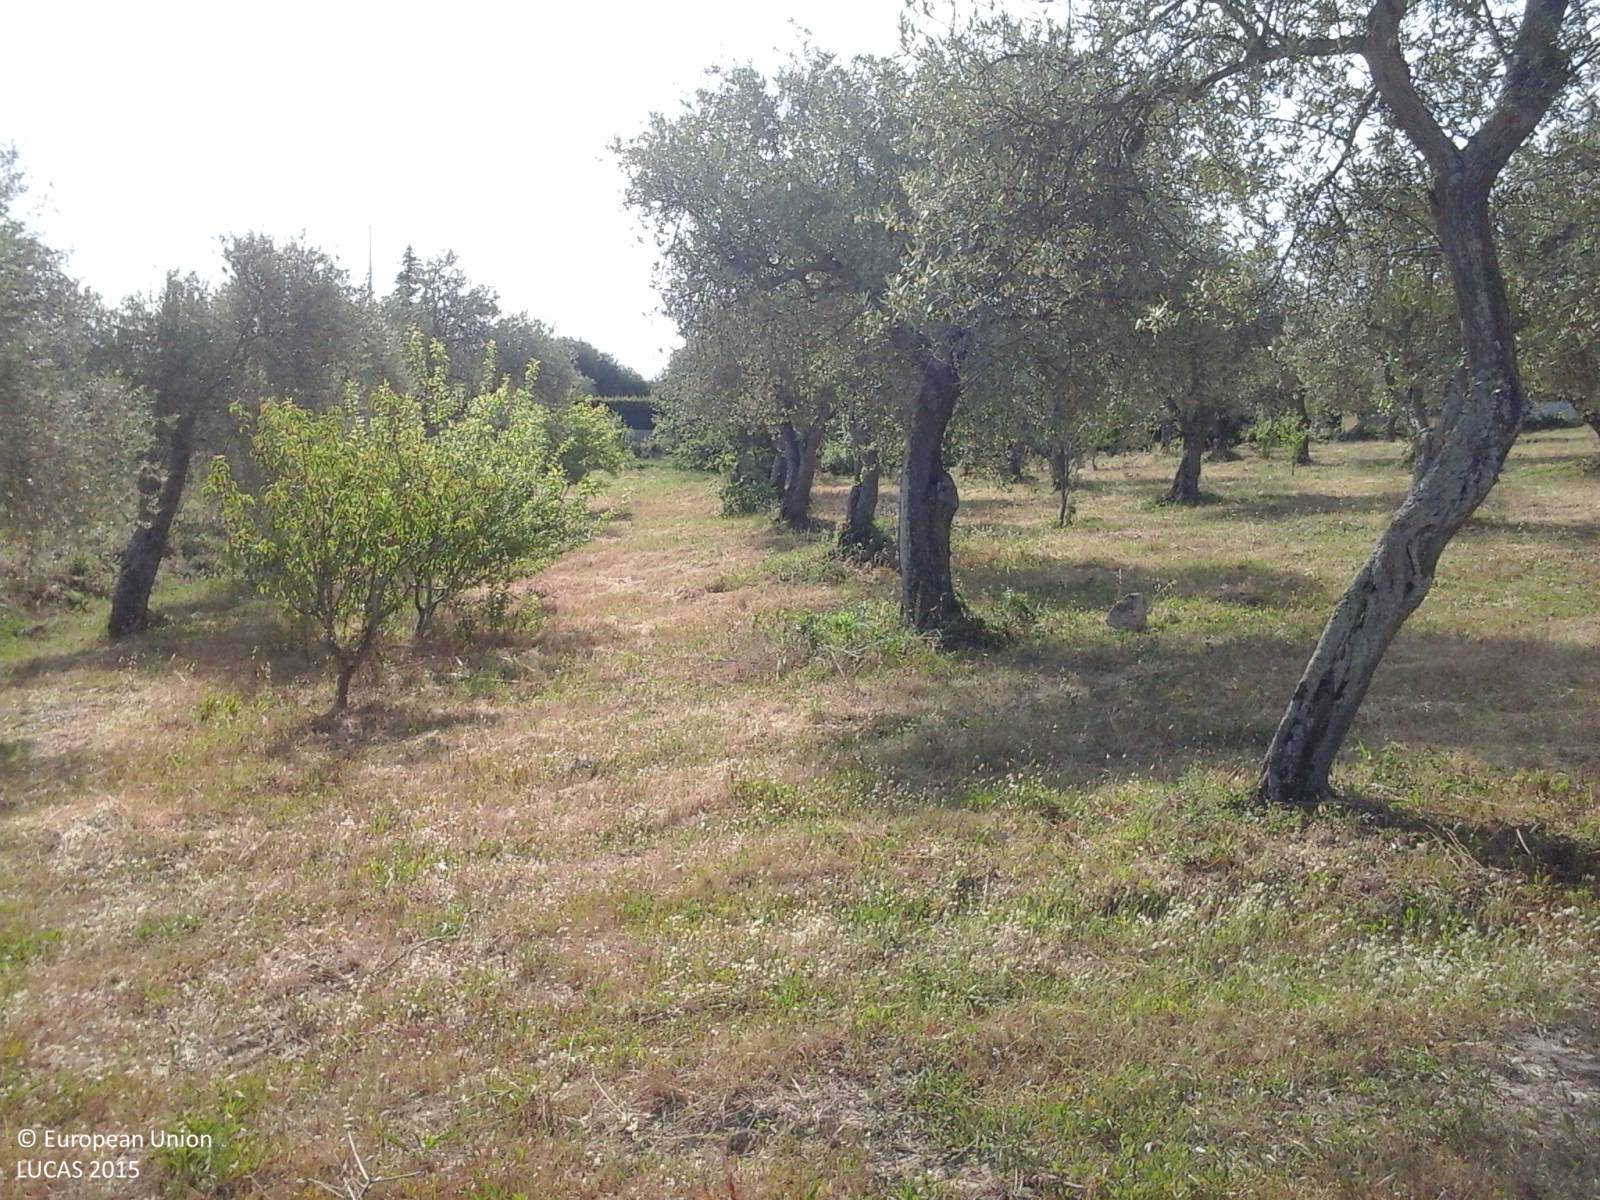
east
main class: Cropland
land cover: Olive groves
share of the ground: > 75 %
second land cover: Grassland without tree/shrub cover
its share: > 75 %
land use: Agriculture (excluding fallow land and kitchen gardens)
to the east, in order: Olive groves; Grassland without tree/shrub cover; Artificial constructions in urban areas; Abandoned hedges; Olive groves
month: May
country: IT
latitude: 40.7638
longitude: 8.5734
